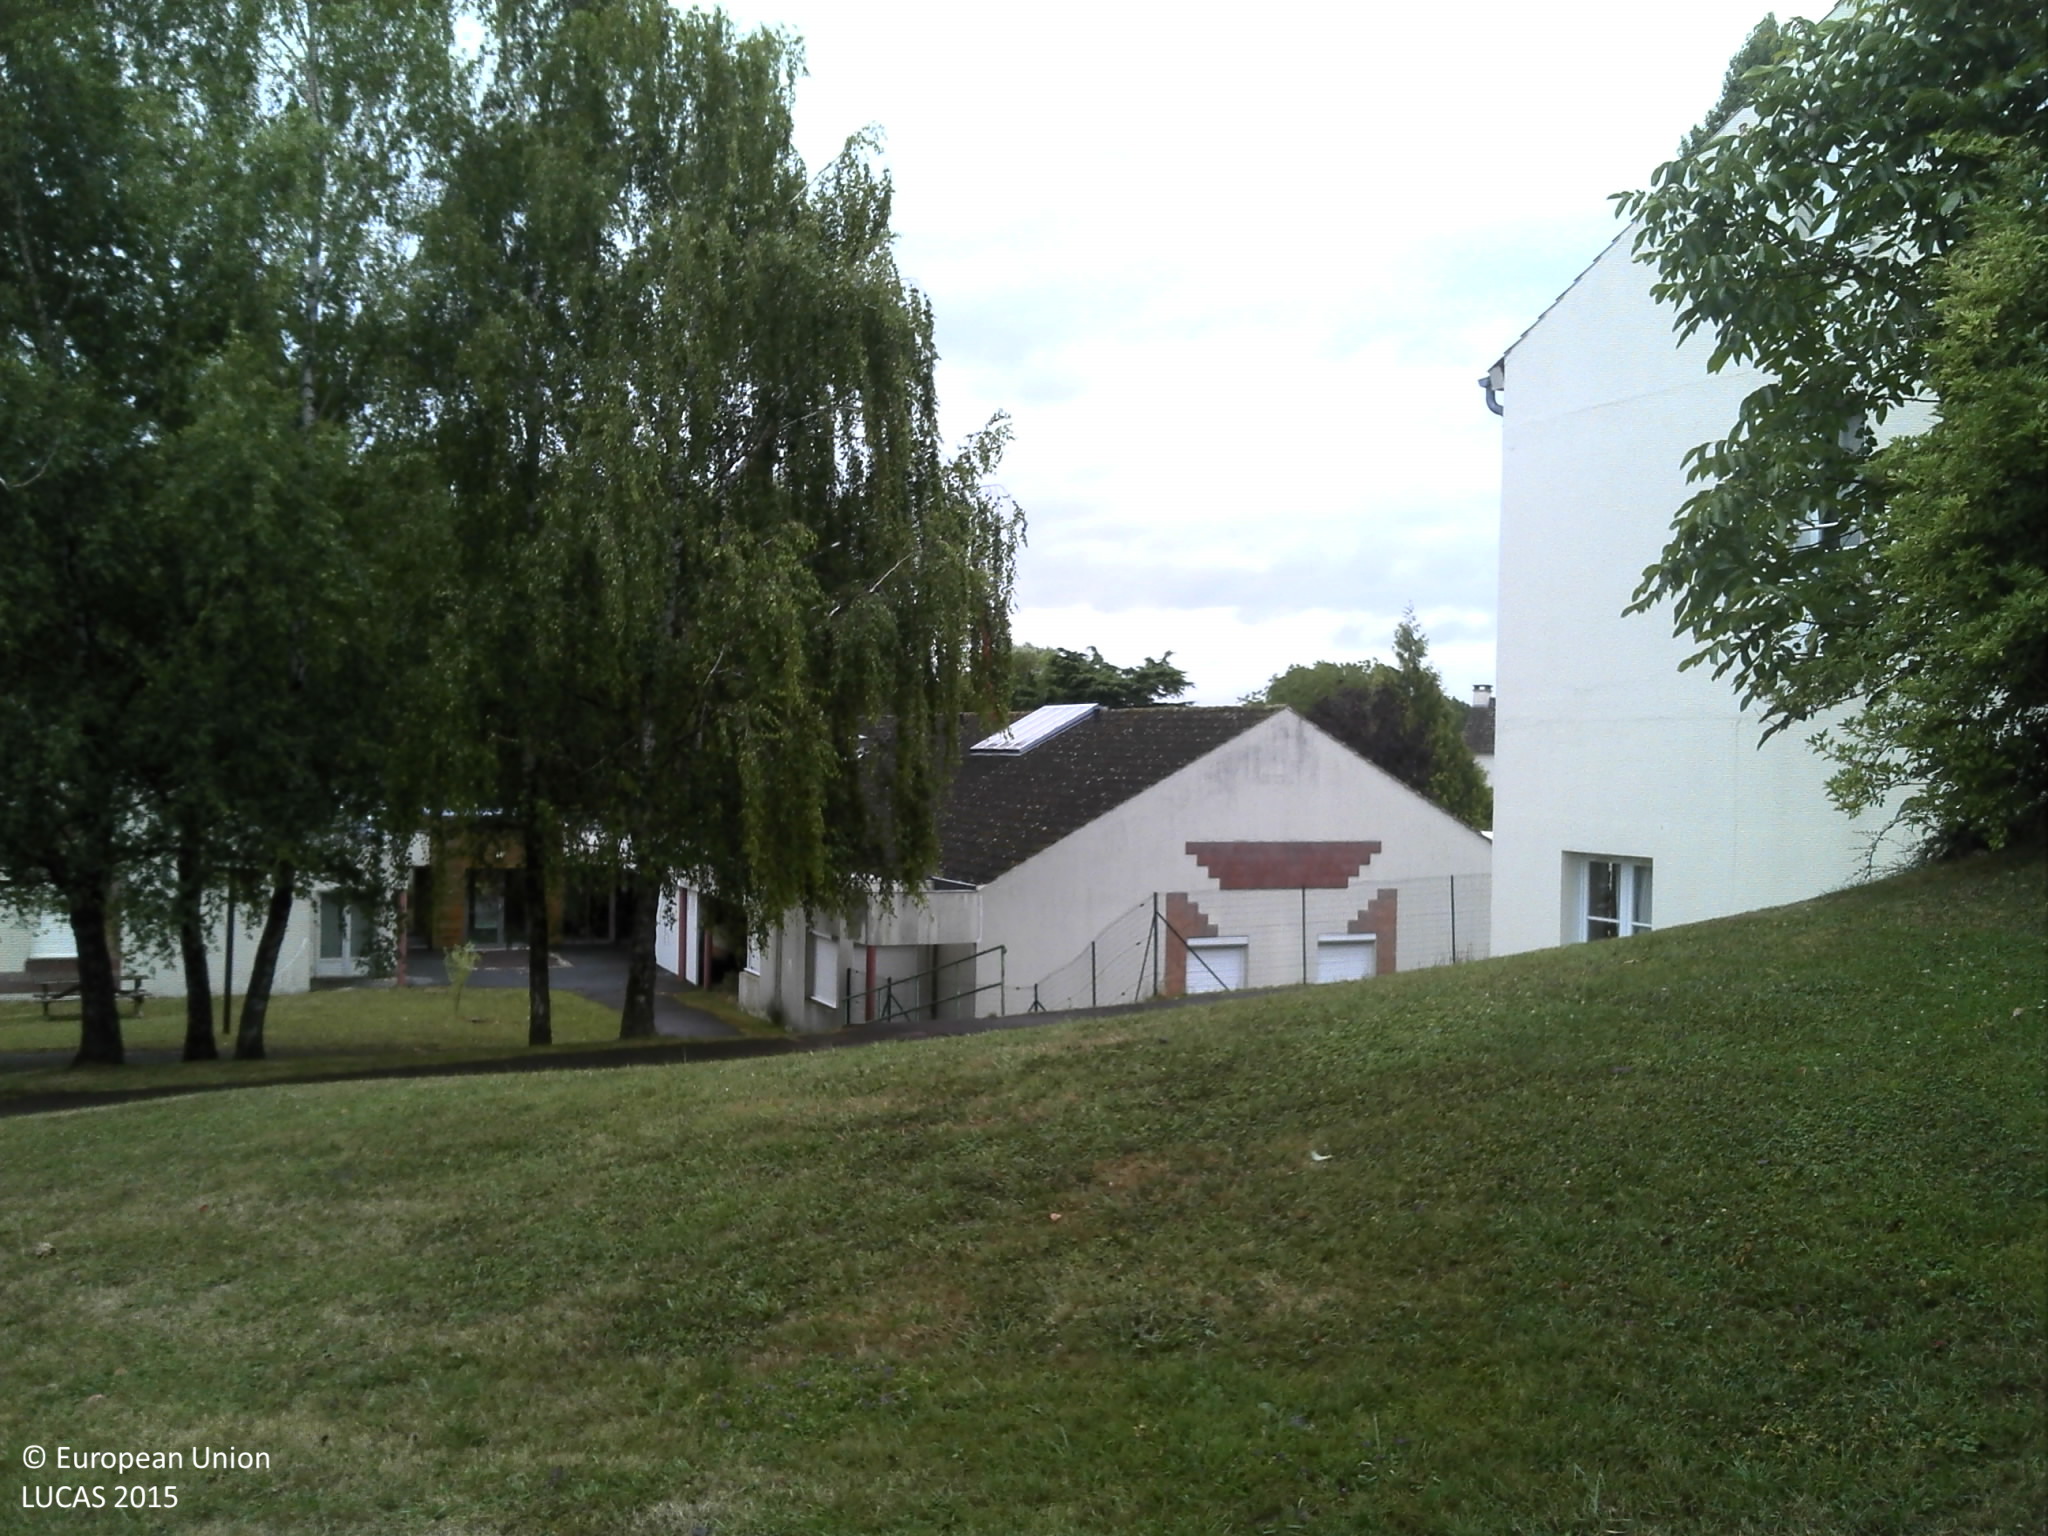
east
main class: Grassland
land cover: Grassland with sparse tree/shrub cover
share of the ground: > 75 %
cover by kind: herbaceous plants 95 %, broadleaved forest trees 5 %
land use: Residential
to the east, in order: Grassland with sparse tree/shrub cover; Managed hedges; Fences; Other fresh vegetables; Fences; Tracks; Grassland with sparse tree/shrub cover; Grassland without tree/shrub cover; Artificial constructions in urban areas; Broadleaved woodland; Fences; Broadleaved woodland; Artificial constructions in urban areas; Broadleaved woodland; Grassland without tree/shrub cover; Spontaneously vegetated surfaces; Grassland with sparse tree/shrub cover
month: July
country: FR
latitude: 49.3938
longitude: 4.6923
